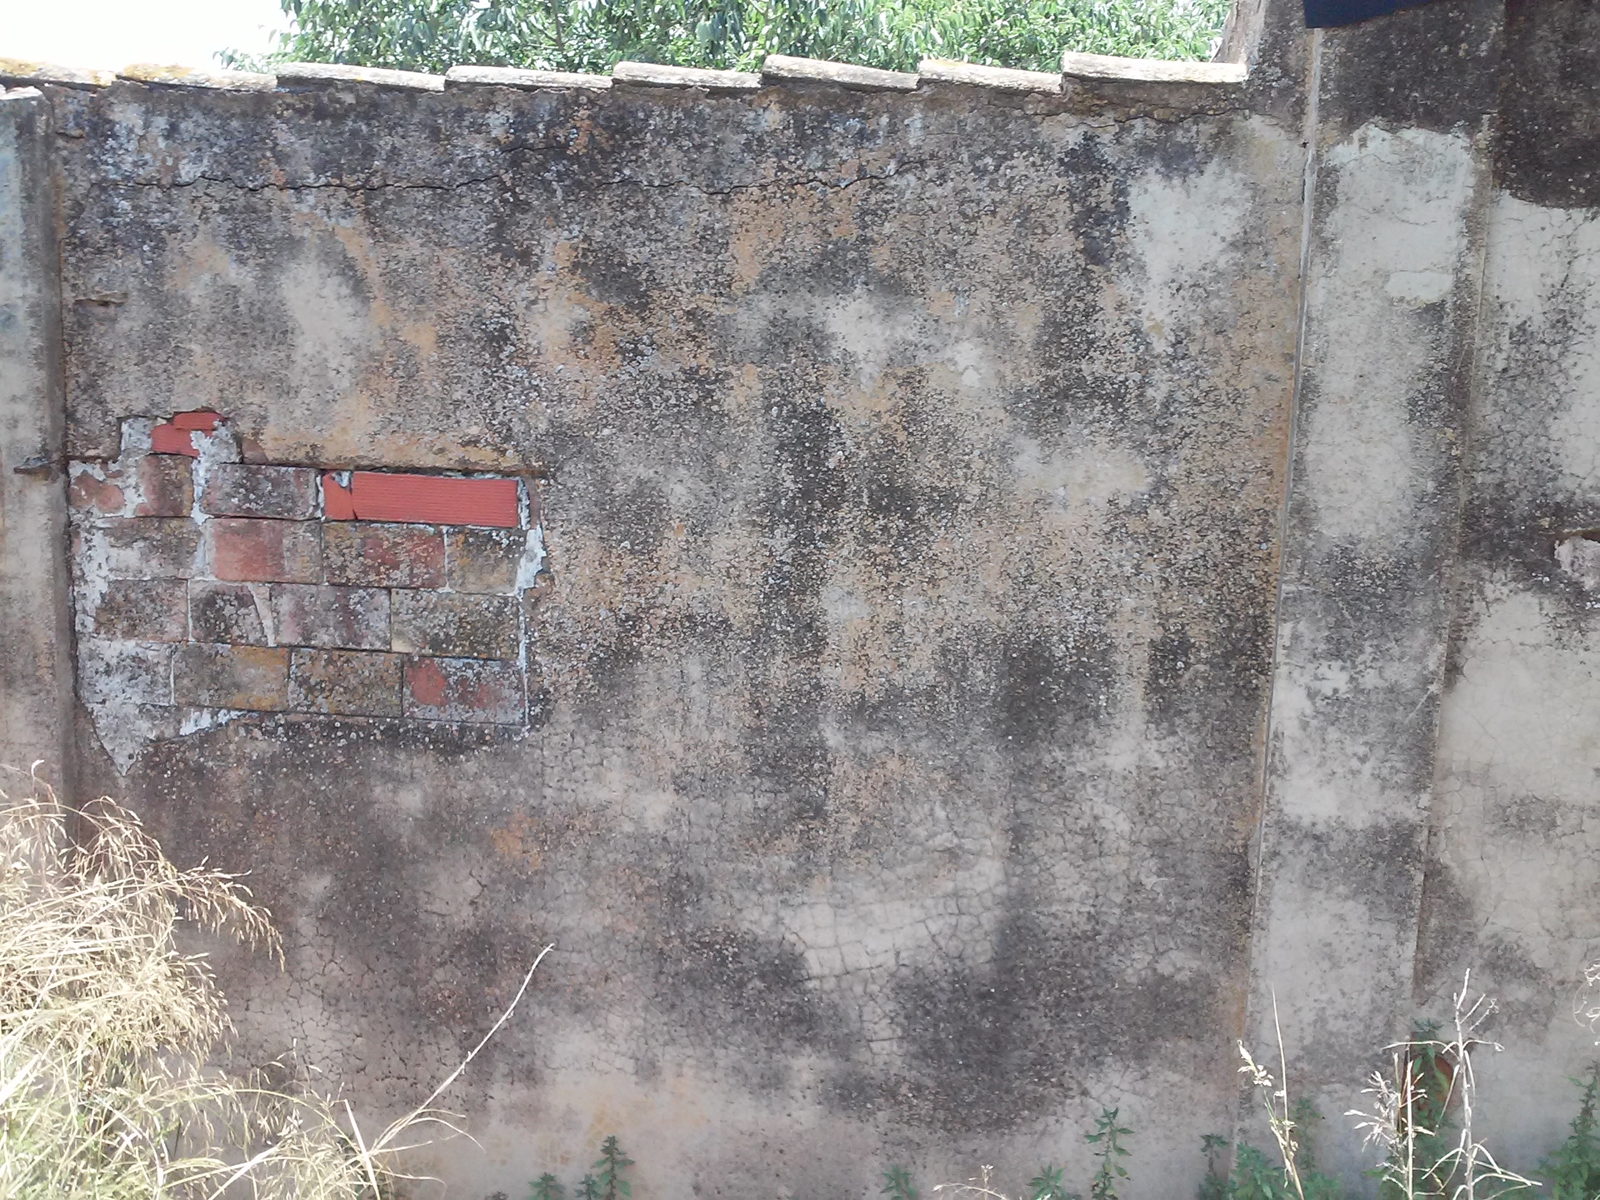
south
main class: Cropland
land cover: Permanent industrial crops
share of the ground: 25 - 50 %
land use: Abandoned areas
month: June
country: ES
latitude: 41.2951
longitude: 1.2631
